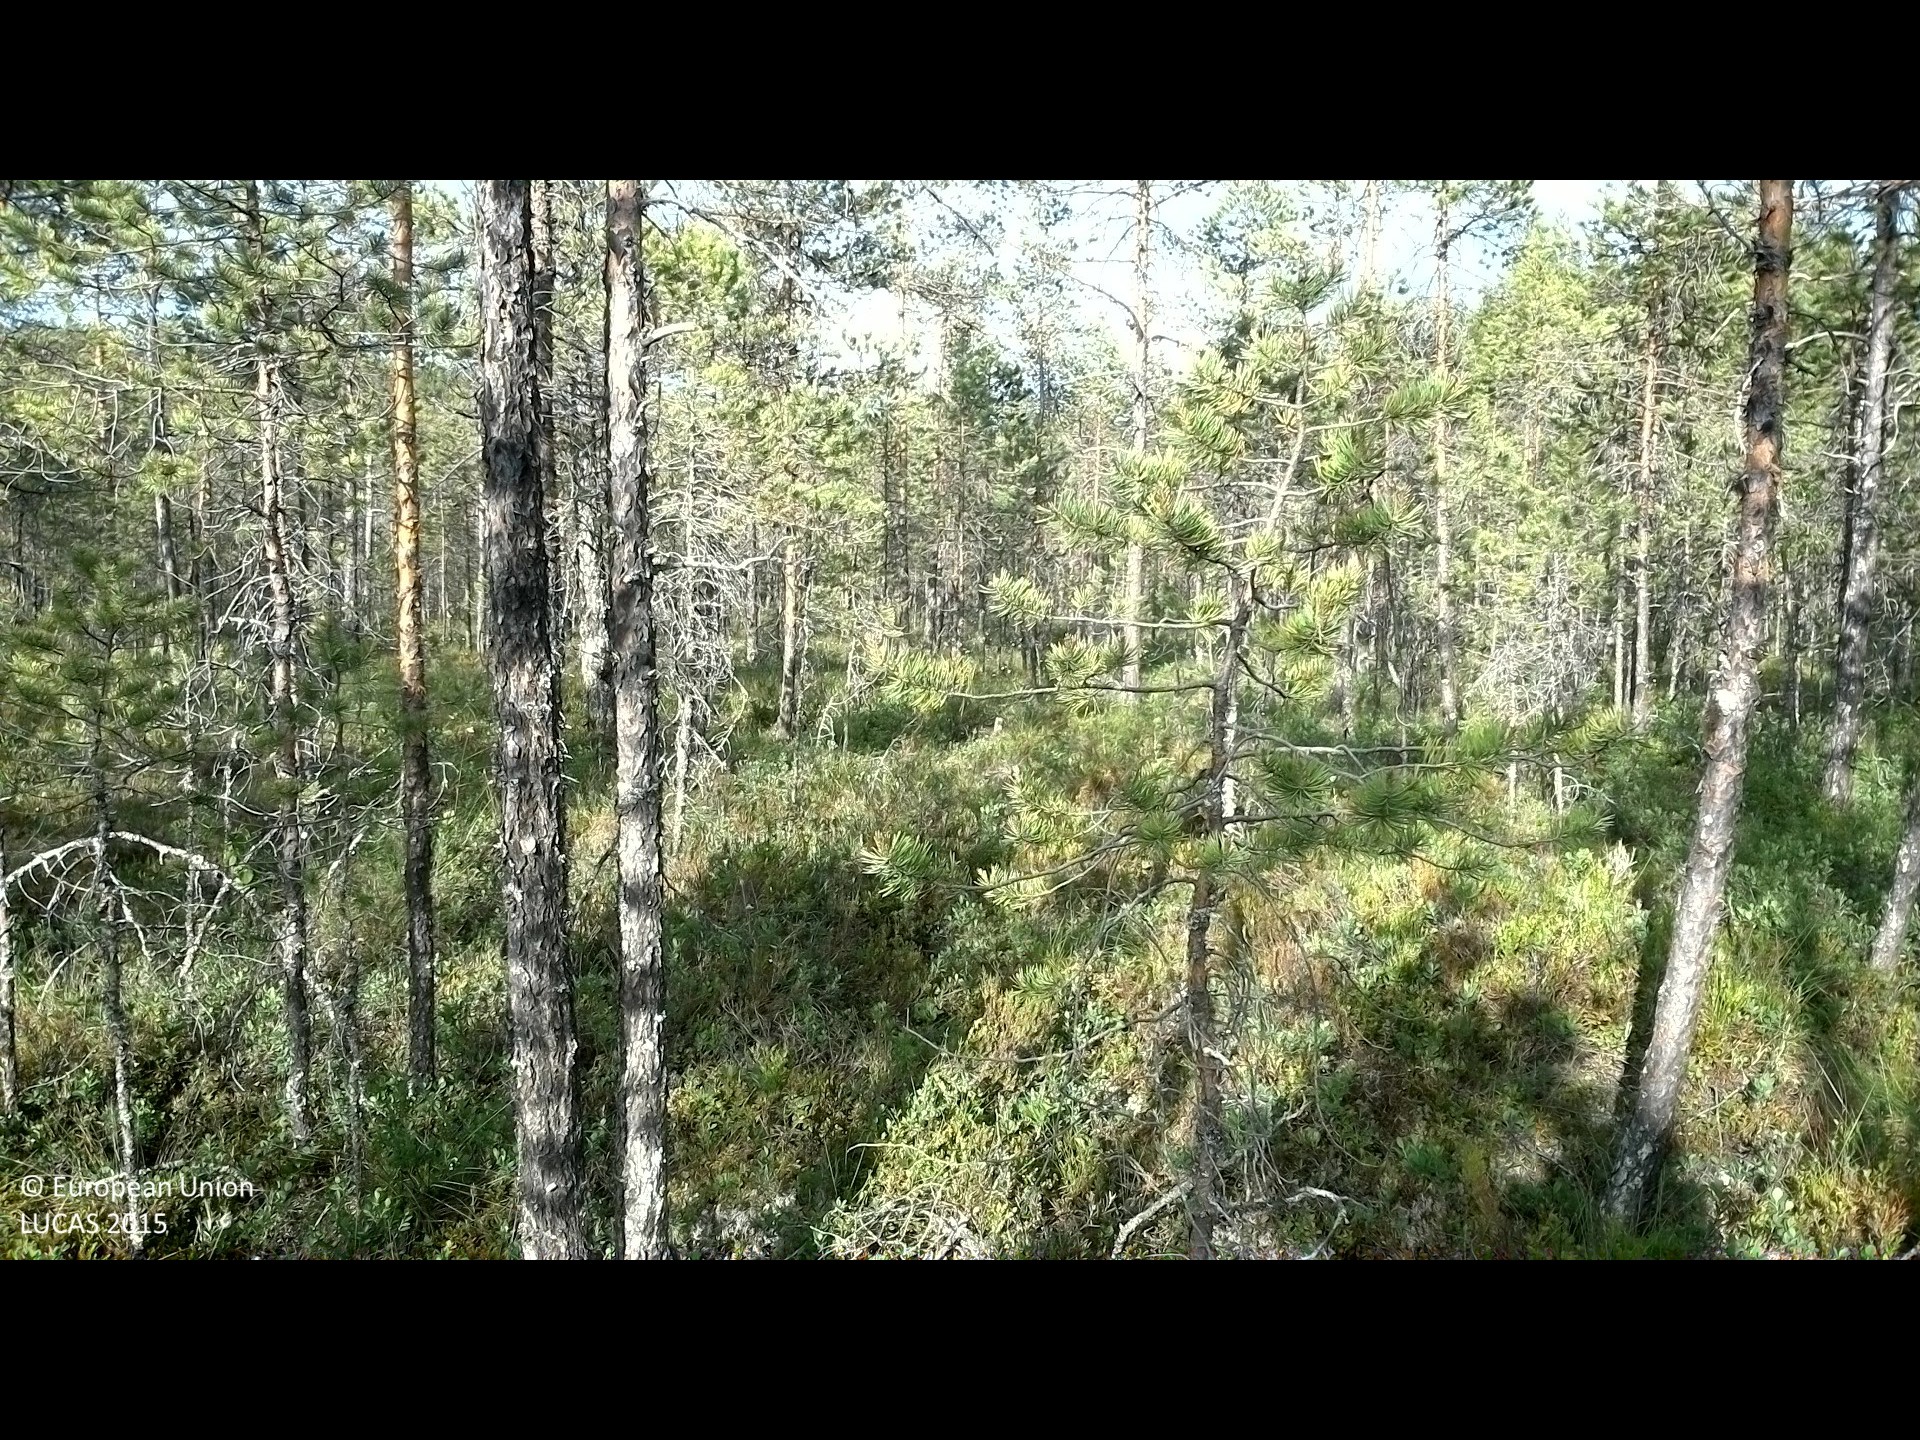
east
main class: Woodland
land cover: Pine dominated coniferous woodland
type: boreal forest
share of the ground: 10 - 25 %
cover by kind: shrubs 40 %, coniferous forest trees 25 %, lichens and mosses 20 %, herbaceous plants 15 %
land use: Forestry
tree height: < 5 m
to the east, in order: Pine dominated coniferous woodland; Broadleaved woodland; Electric lines; Broadleaved woodland; Ditches and canals; Paved roads, cycling and walking lanes; Ditches and canals; Grass margins; Railways; Broadleaved woodland; Spruce dominated mixed woodland
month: June
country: SE
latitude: 61.9524
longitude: 15.9489
